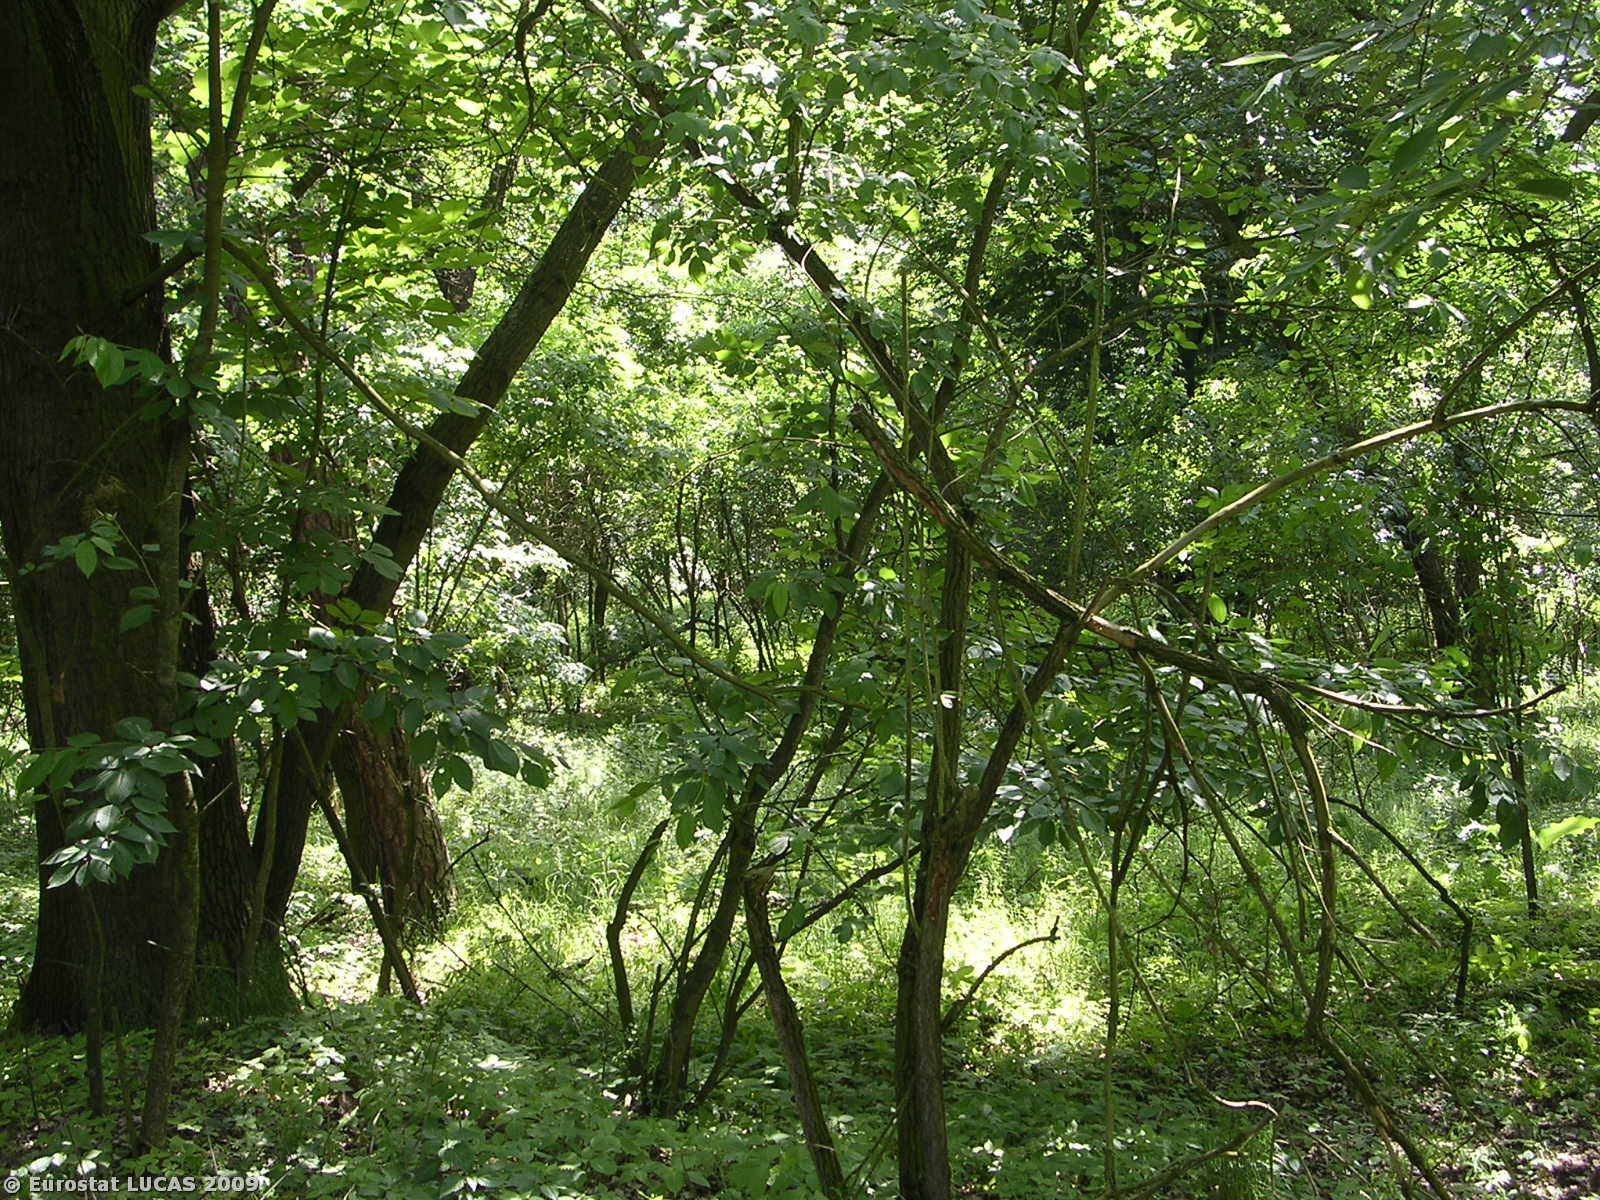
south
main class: Woodland
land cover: Broadleaved woodland
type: hemiboreal forest and nemoral coniferous forest and mixed broadleaved-coniferous forest
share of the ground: > 75 %
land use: Unused
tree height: > 5 m
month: May
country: CZ
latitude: 50.2400
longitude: 14.9241
